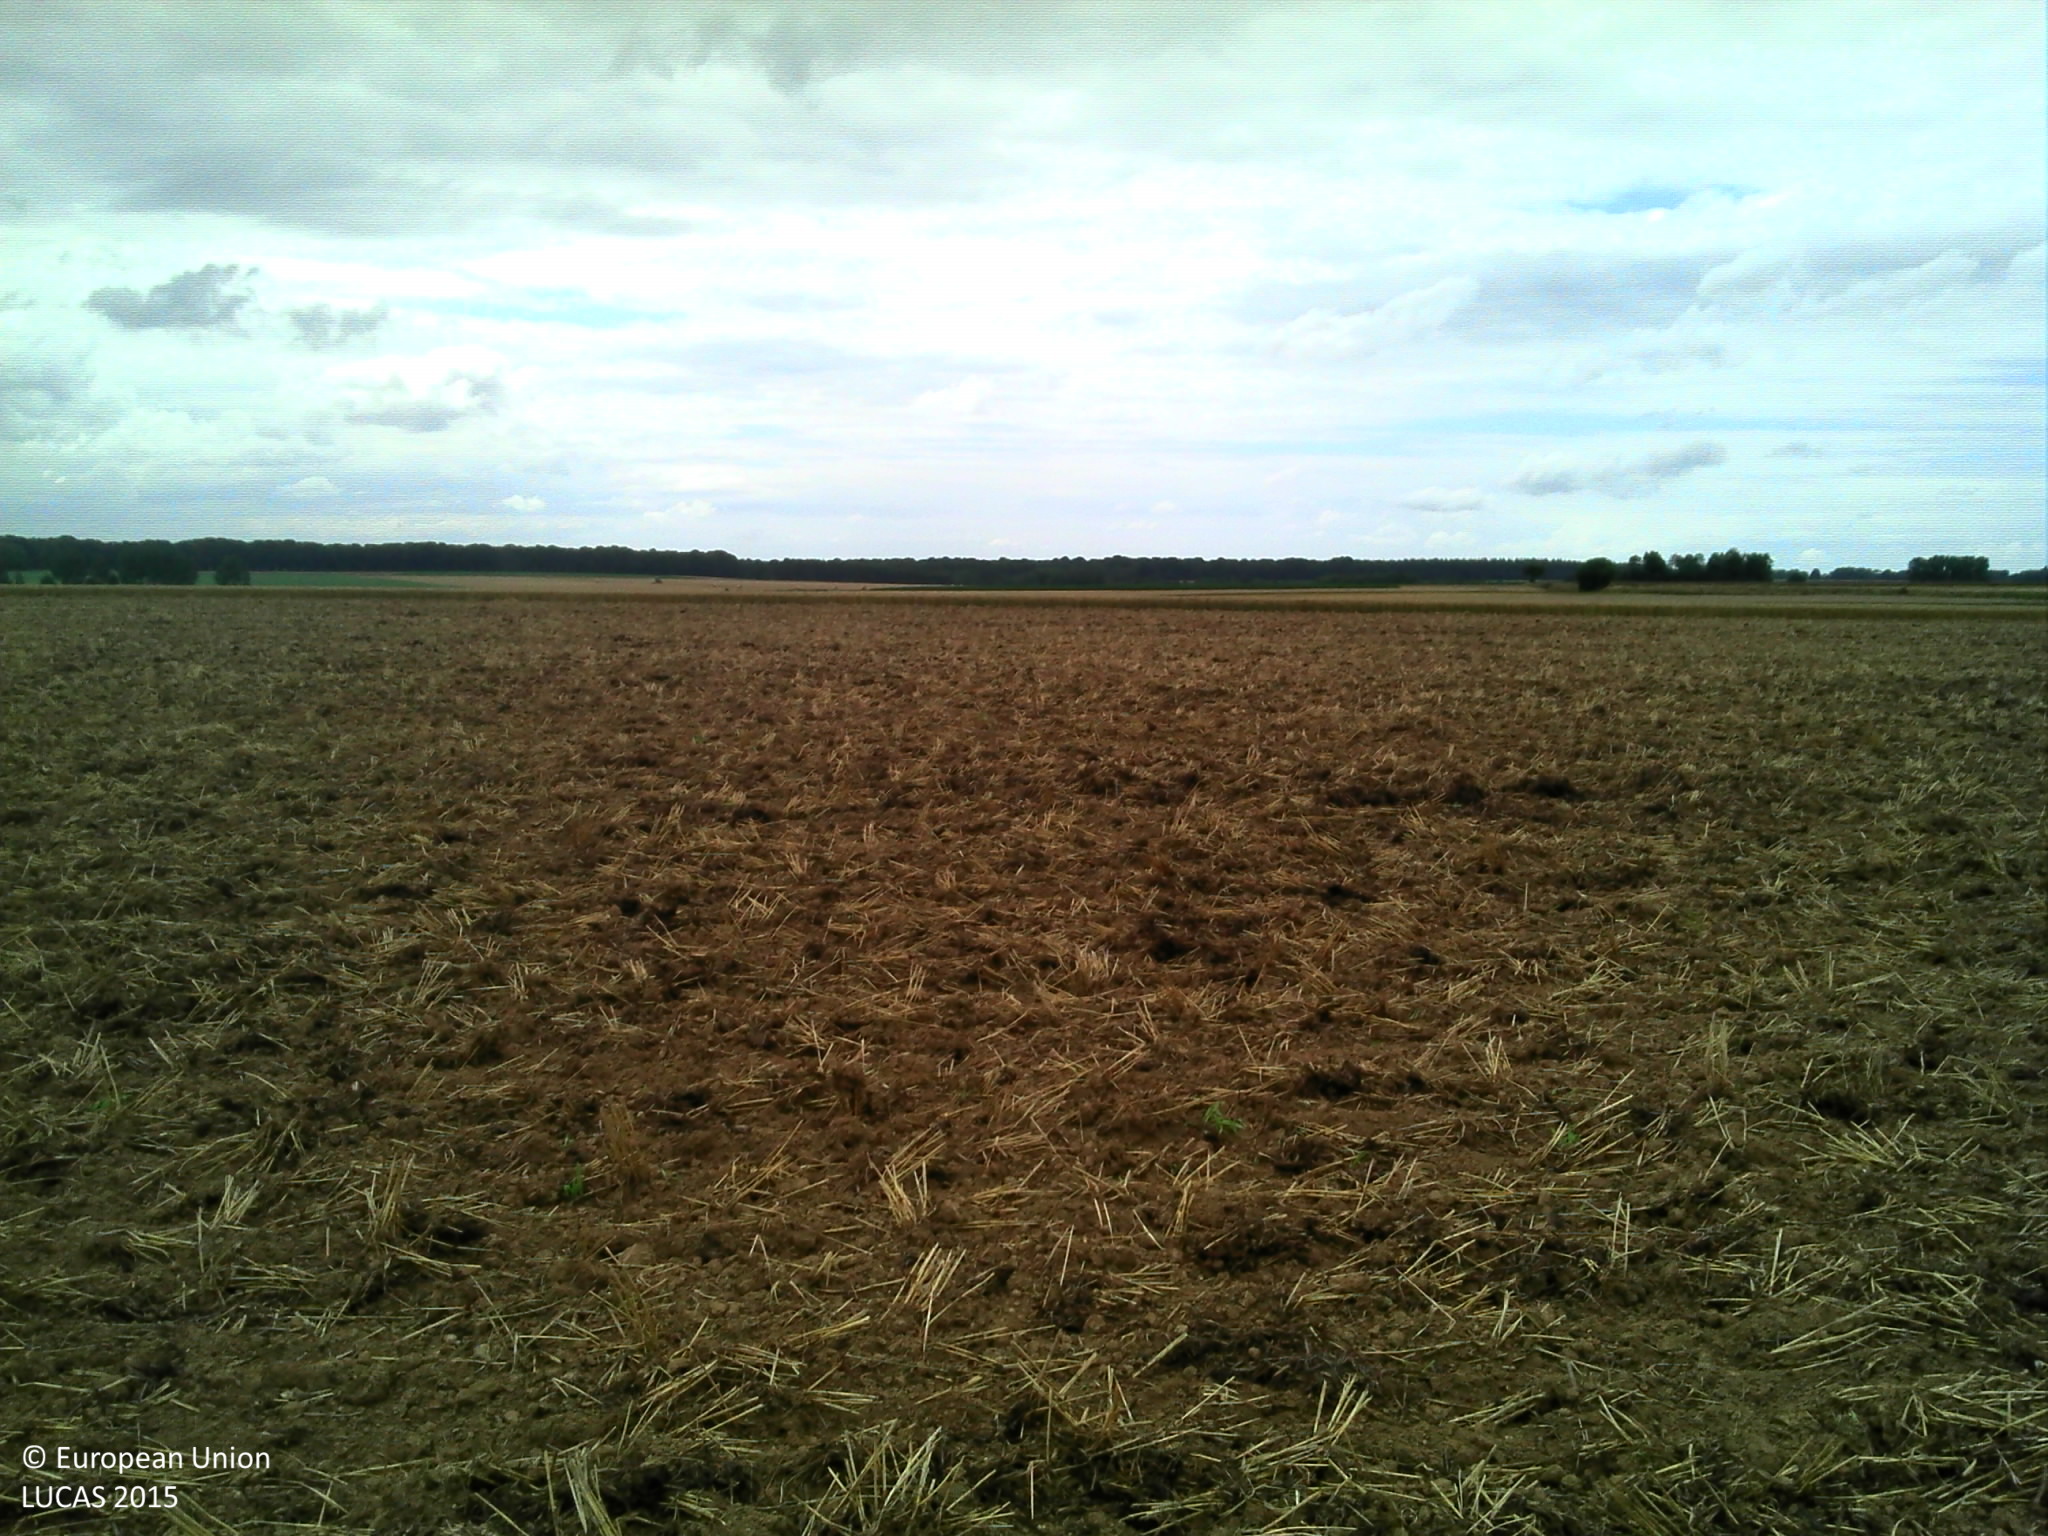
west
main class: Cropland
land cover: Barley
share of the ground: 10 - 25 %
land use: Agriculture (excluding fallow land and kitchen gardens)
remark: Harvested field
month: July
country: FR
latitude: 50.1293
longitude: 2.1376
